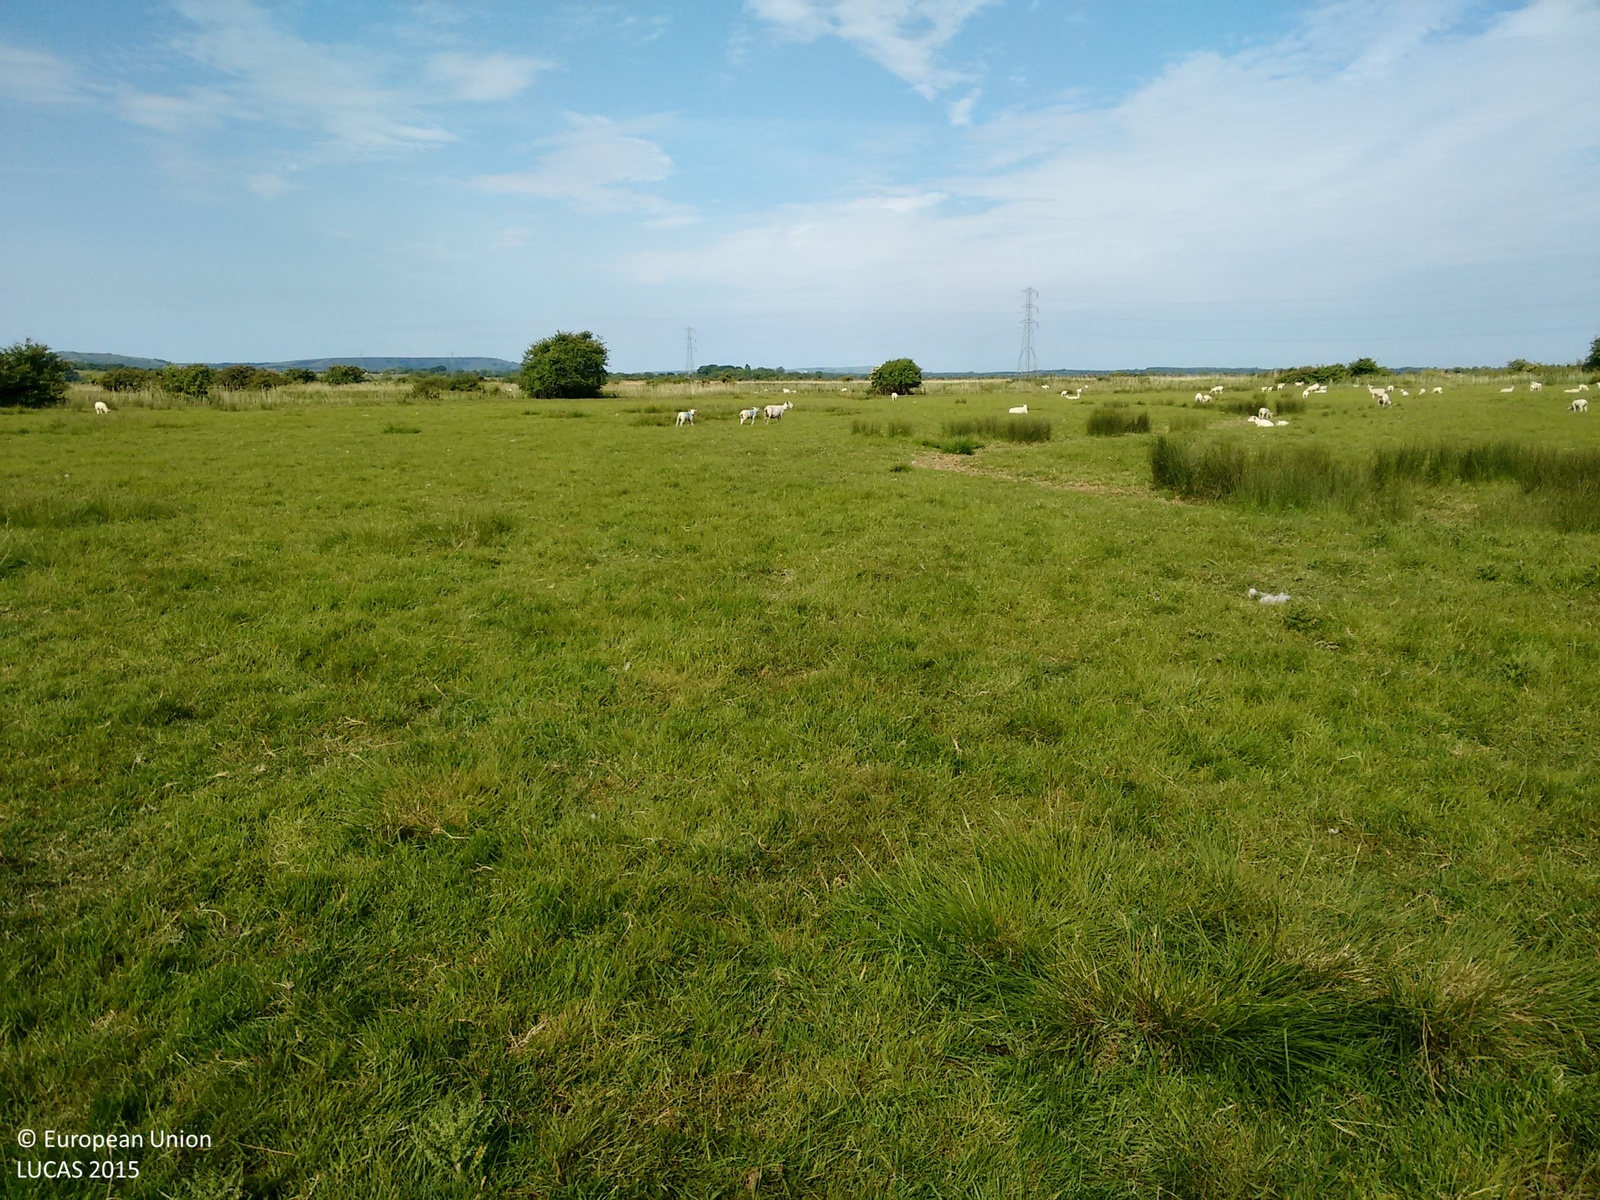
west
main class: Grassland
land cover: Grassland without tree/shrub cover
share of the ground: > 75 %
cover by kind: herbaceous plants 100 %
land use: Agriculture (excluding fallow land and kitchen gardens)
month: June
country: GB
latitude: 50.8407
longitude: 0.3281
